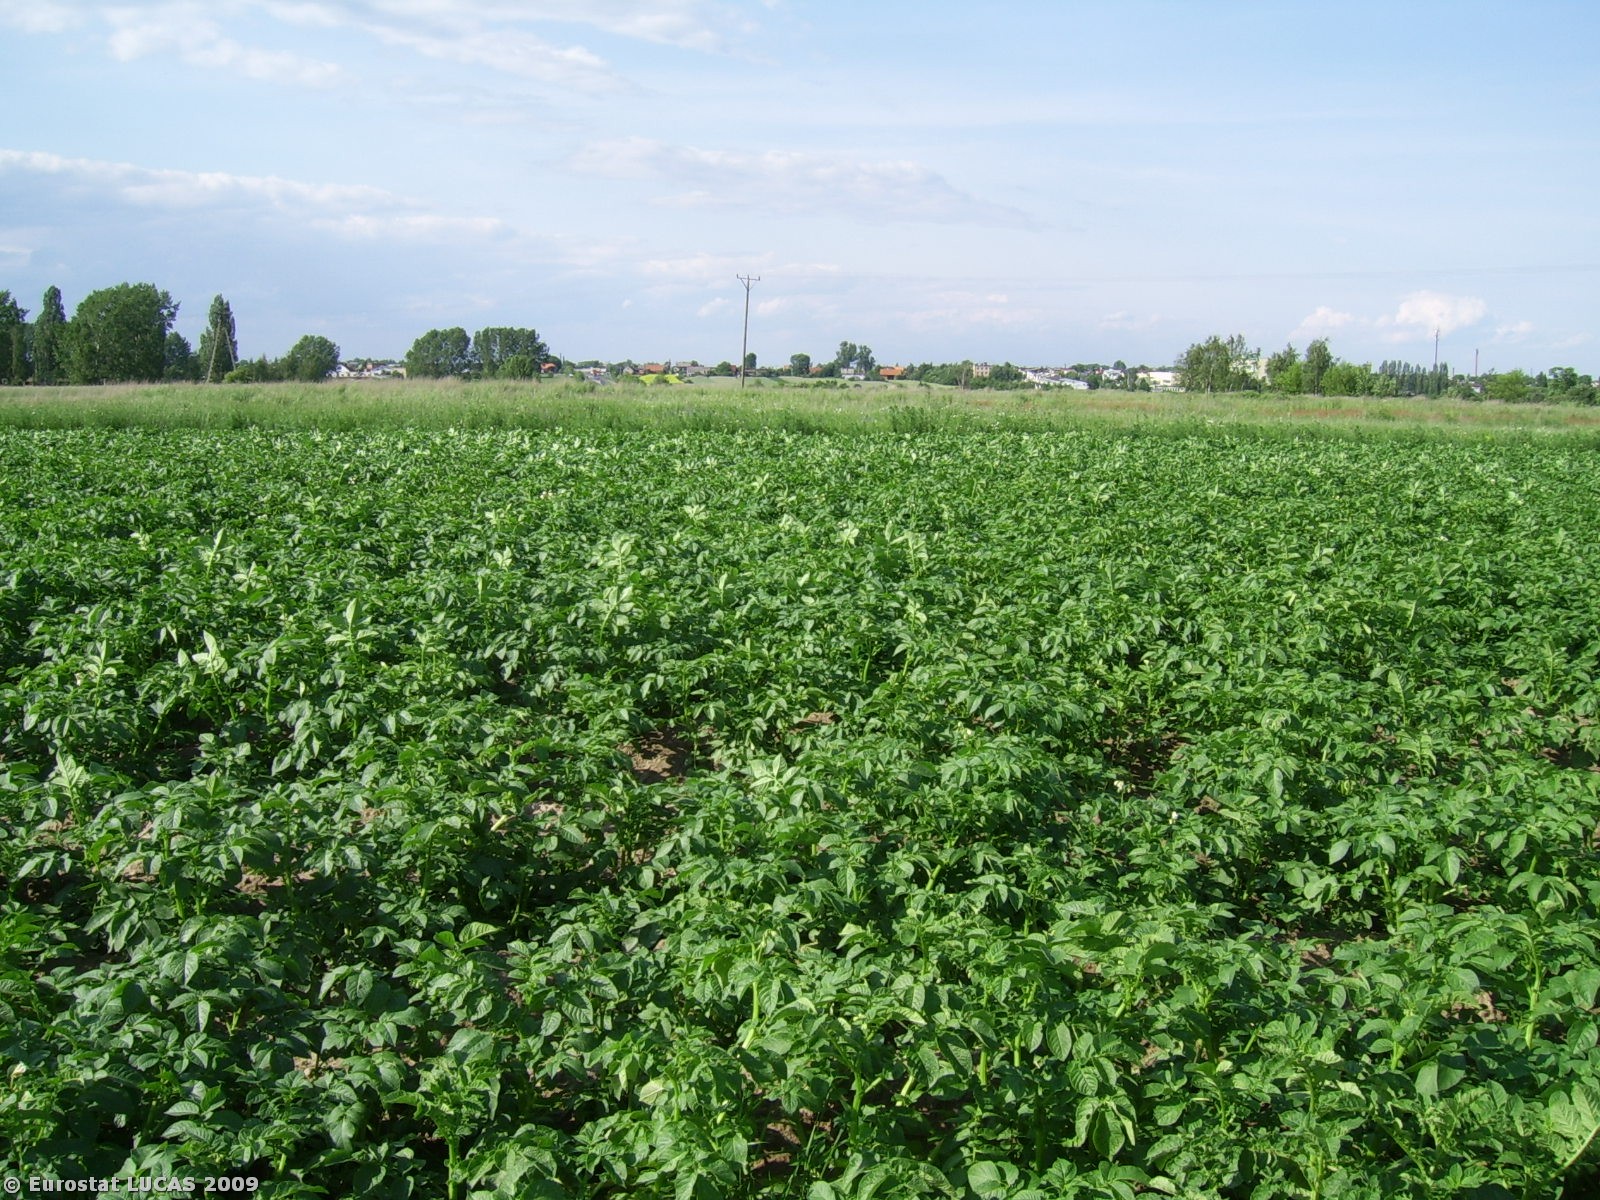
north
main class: Cropland
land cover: Triticale
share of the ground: > 75 %
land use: Agriculture (excluding fallow land and kitchen gardens)
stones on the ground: < 10 %
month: June
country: PL
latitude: 51.8886
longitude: 17.7586
